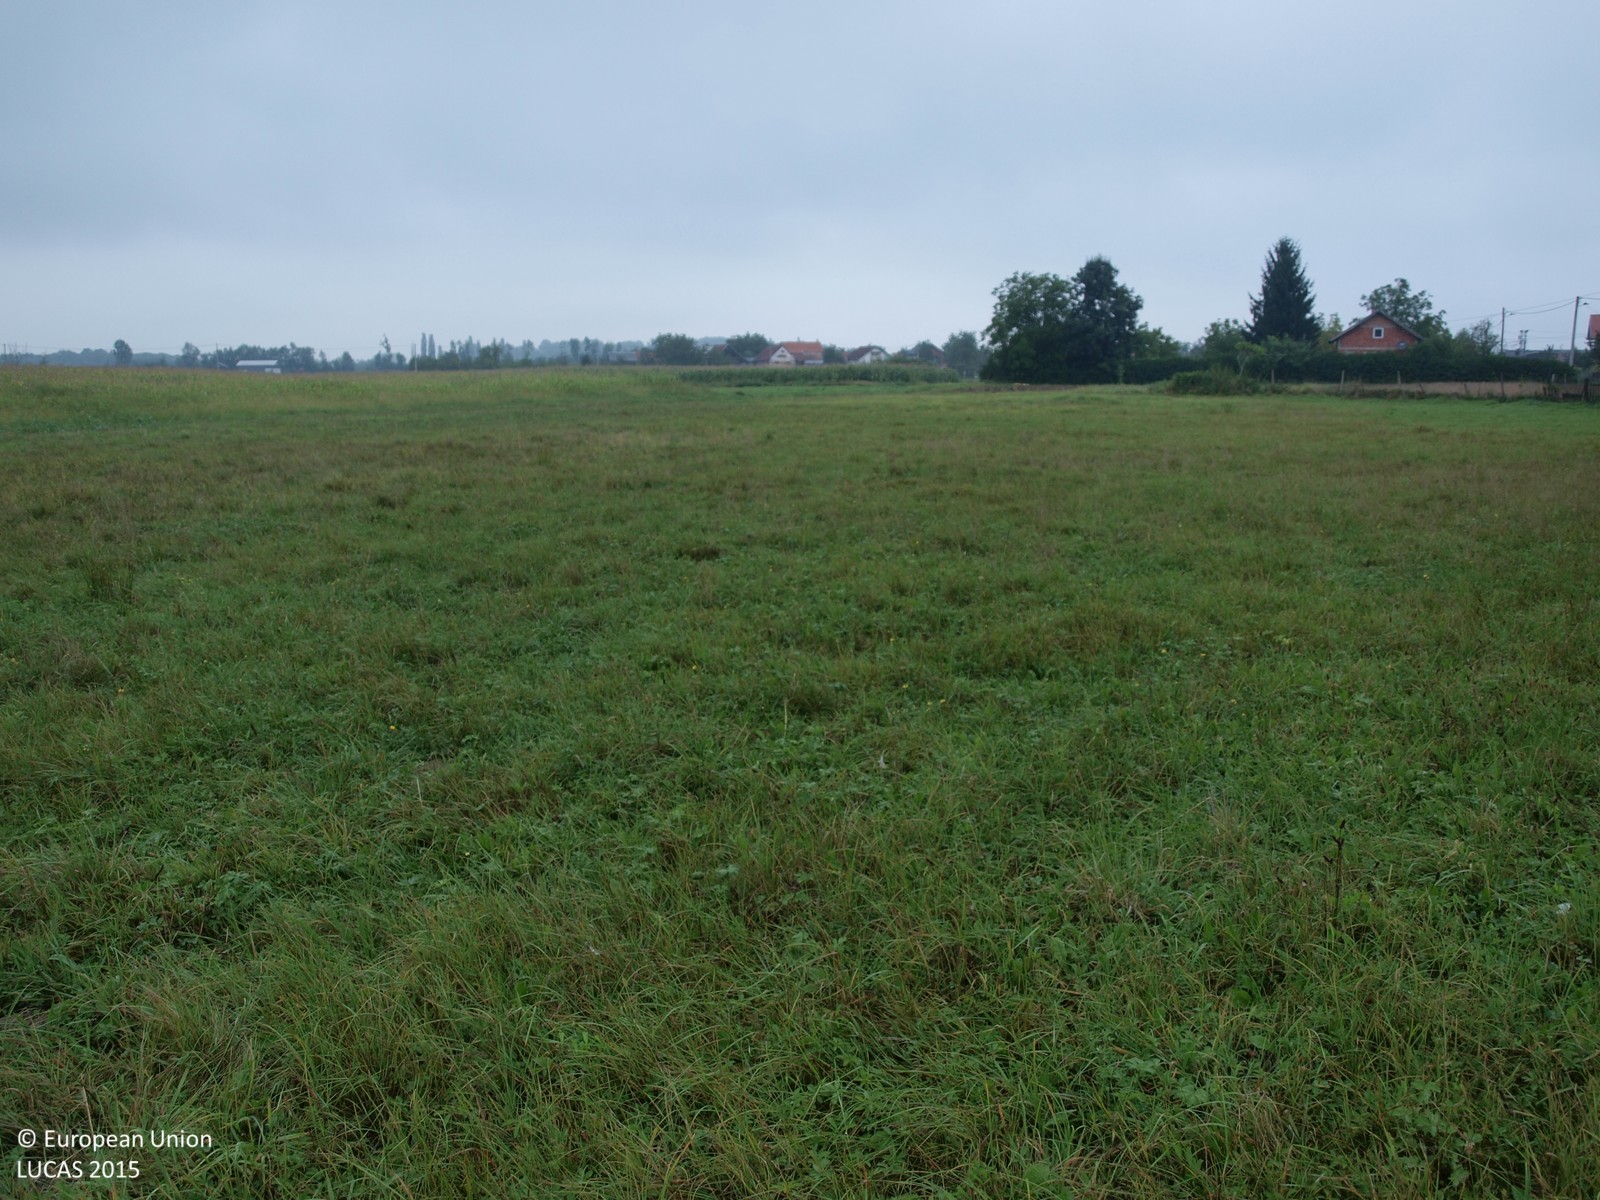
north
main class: Grassland
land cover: Grassland without tree/shrub cover
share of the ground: > 75 %
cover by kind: herbaceous plants 100 %
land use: Agriculture (excluding fallow land and kitchen gardens)
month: August
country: HR
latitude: 45.8047
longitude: 16.2907
